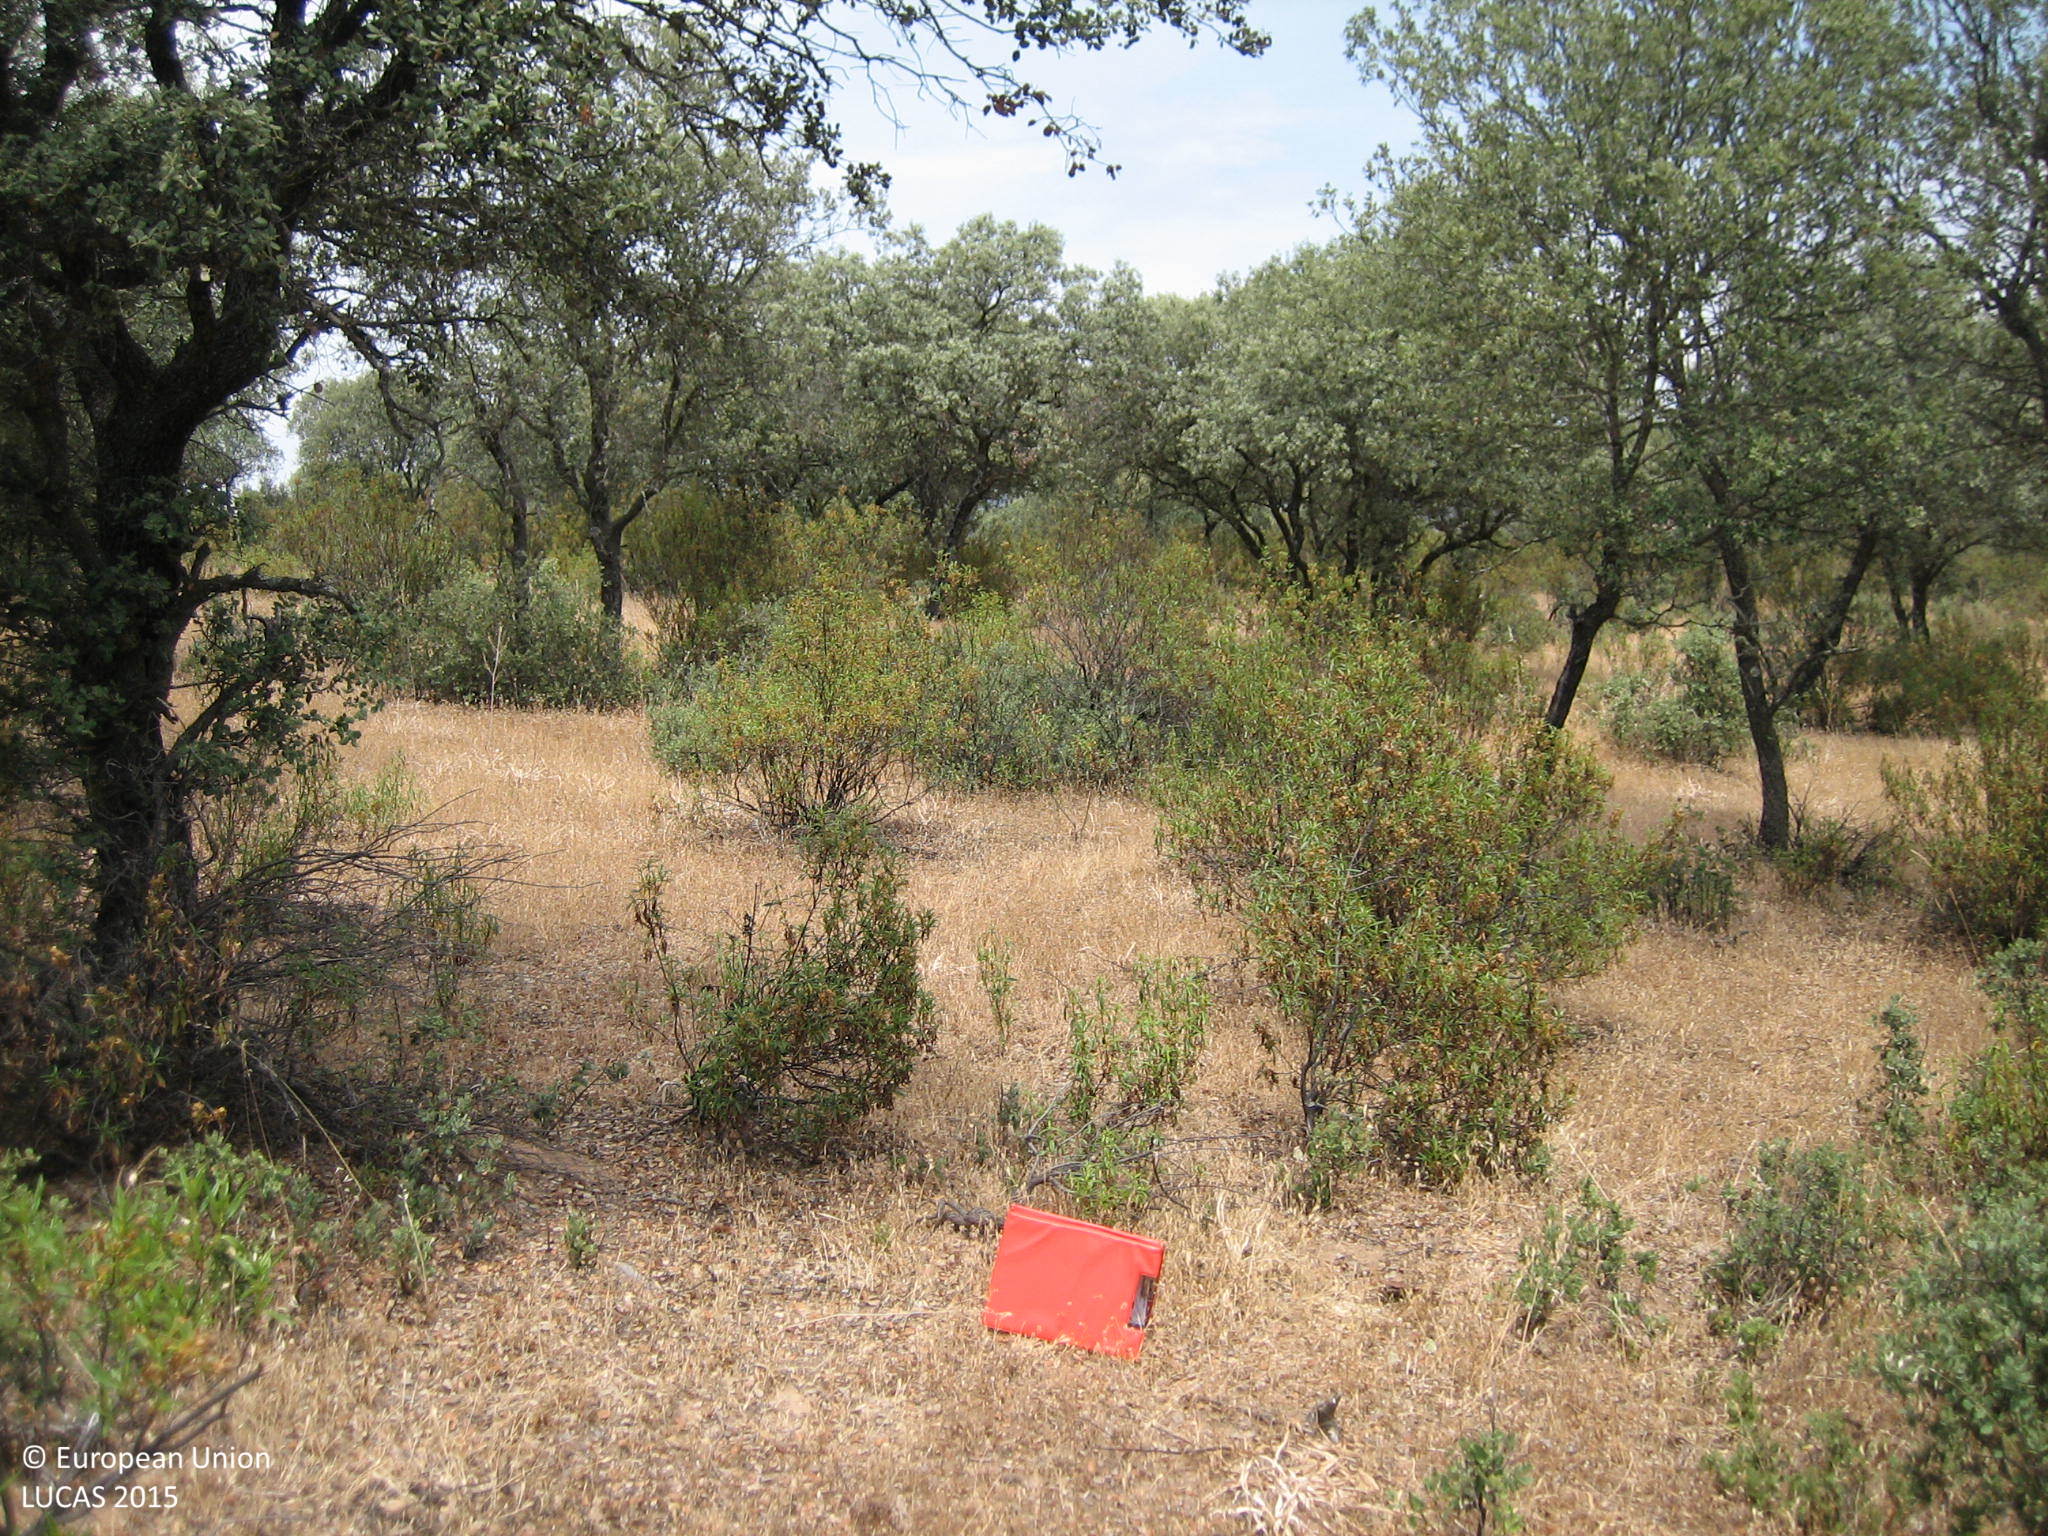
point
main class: Shrubland
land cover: Shrubland with sparse tree cover
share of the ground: 50 - 75 %
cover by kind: herbaceous plants 55 %, shrubs 40 %, broadleaved forest trees 5 %
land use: Semi-natural and natural areas not in use
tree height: > 5 m
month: June
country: ES
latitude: 39.1961
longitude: -4.5400
